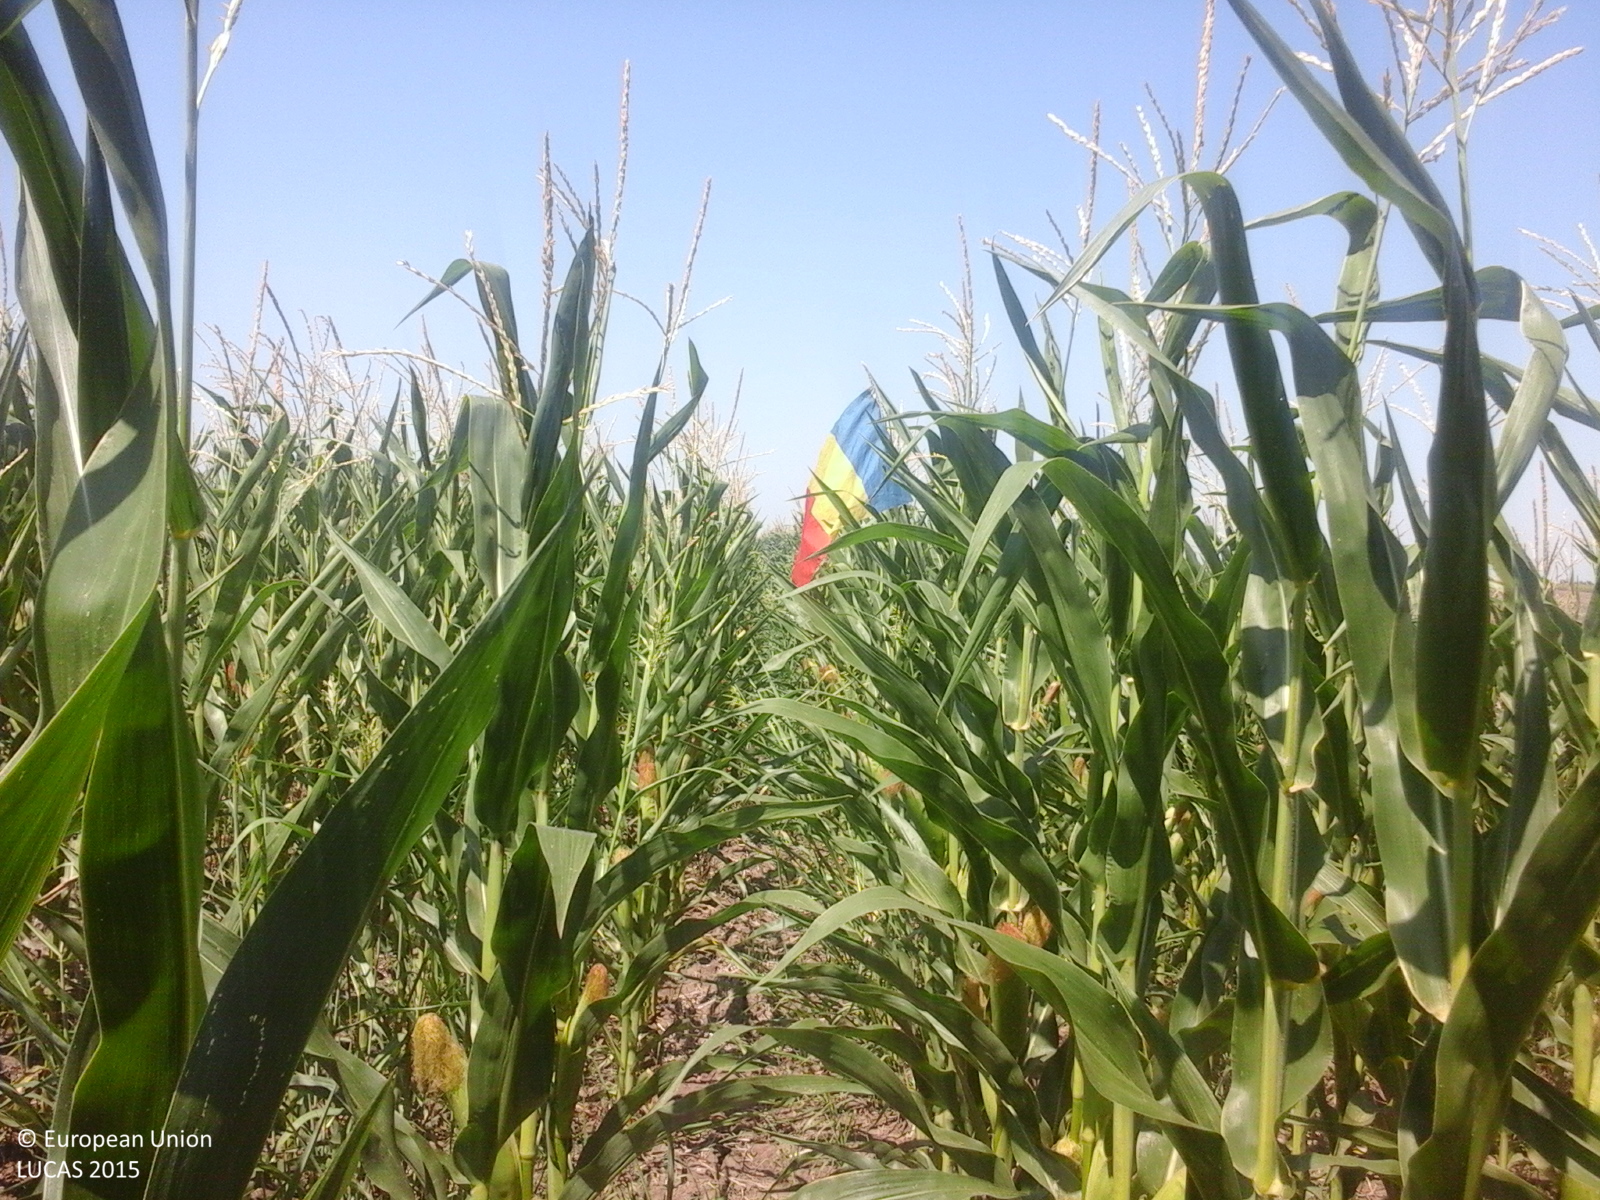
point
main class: Cropland
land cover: Maize
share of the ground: > 75 %
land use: Agriculture (excluding fallow land and kitchen gardens)
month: July
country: RO
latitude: 44.2252
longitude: 26.6534
